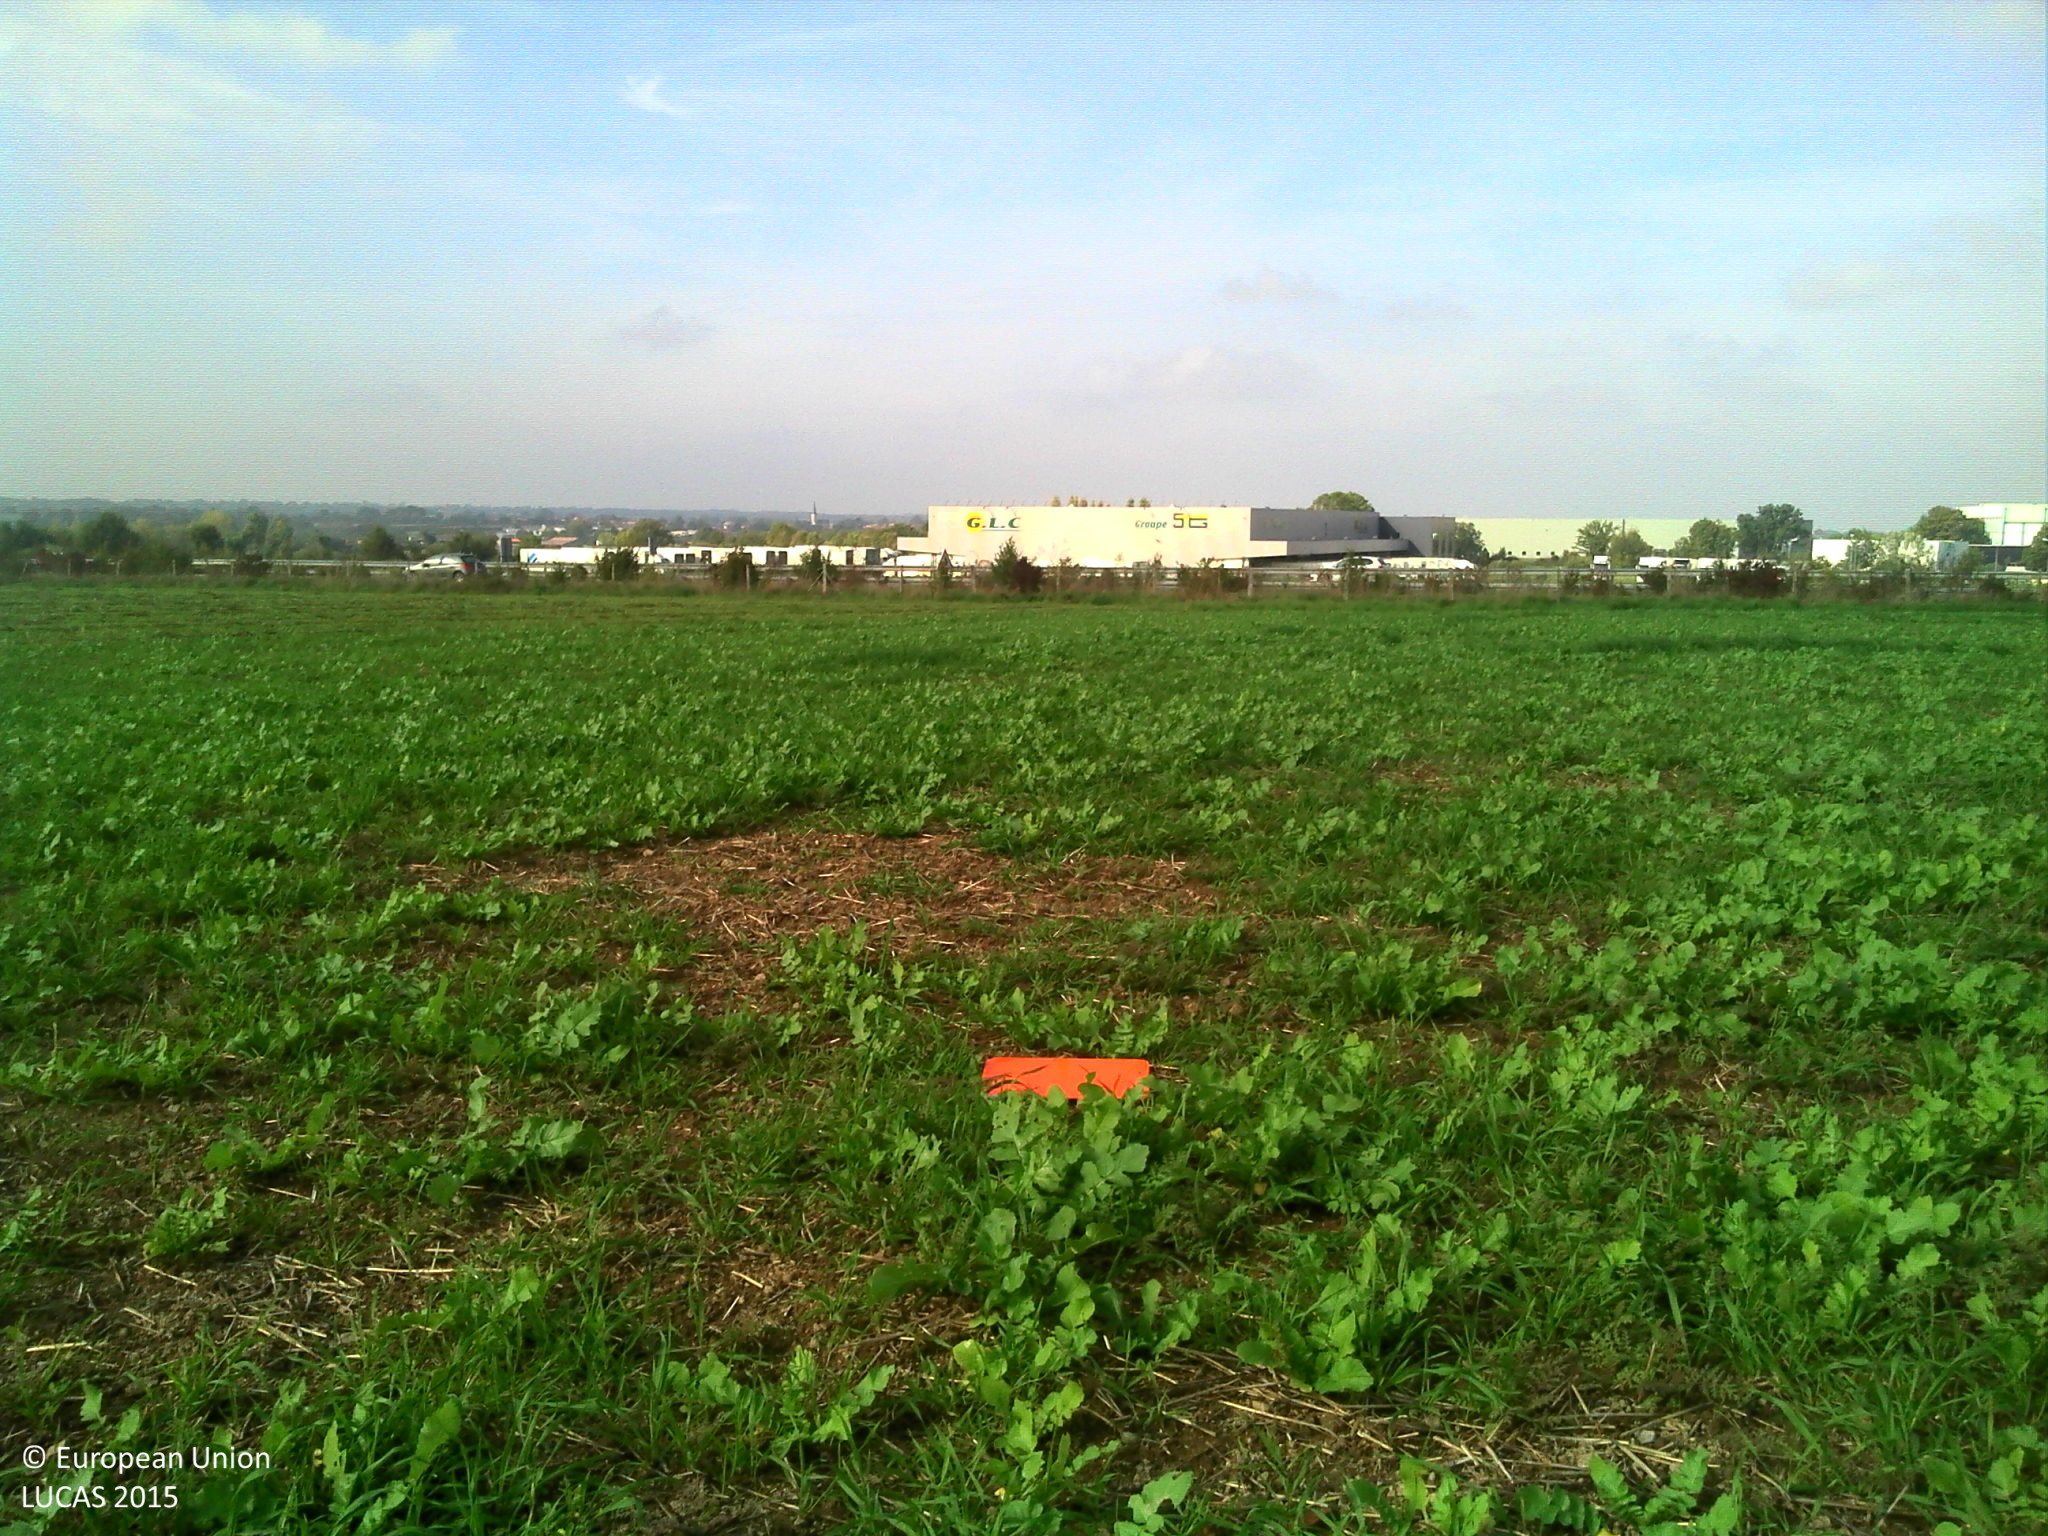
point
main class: Grassland
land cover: Spontaneously vegetated surfaces
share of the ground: > 75 %
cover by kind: herbaceous plants 95 %, unconsolidated bare surface 5 %
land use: Agriculture (excluding fallow land and kitchen gardens)
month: October
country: FR
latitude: 47.0262
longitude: -0.9148
